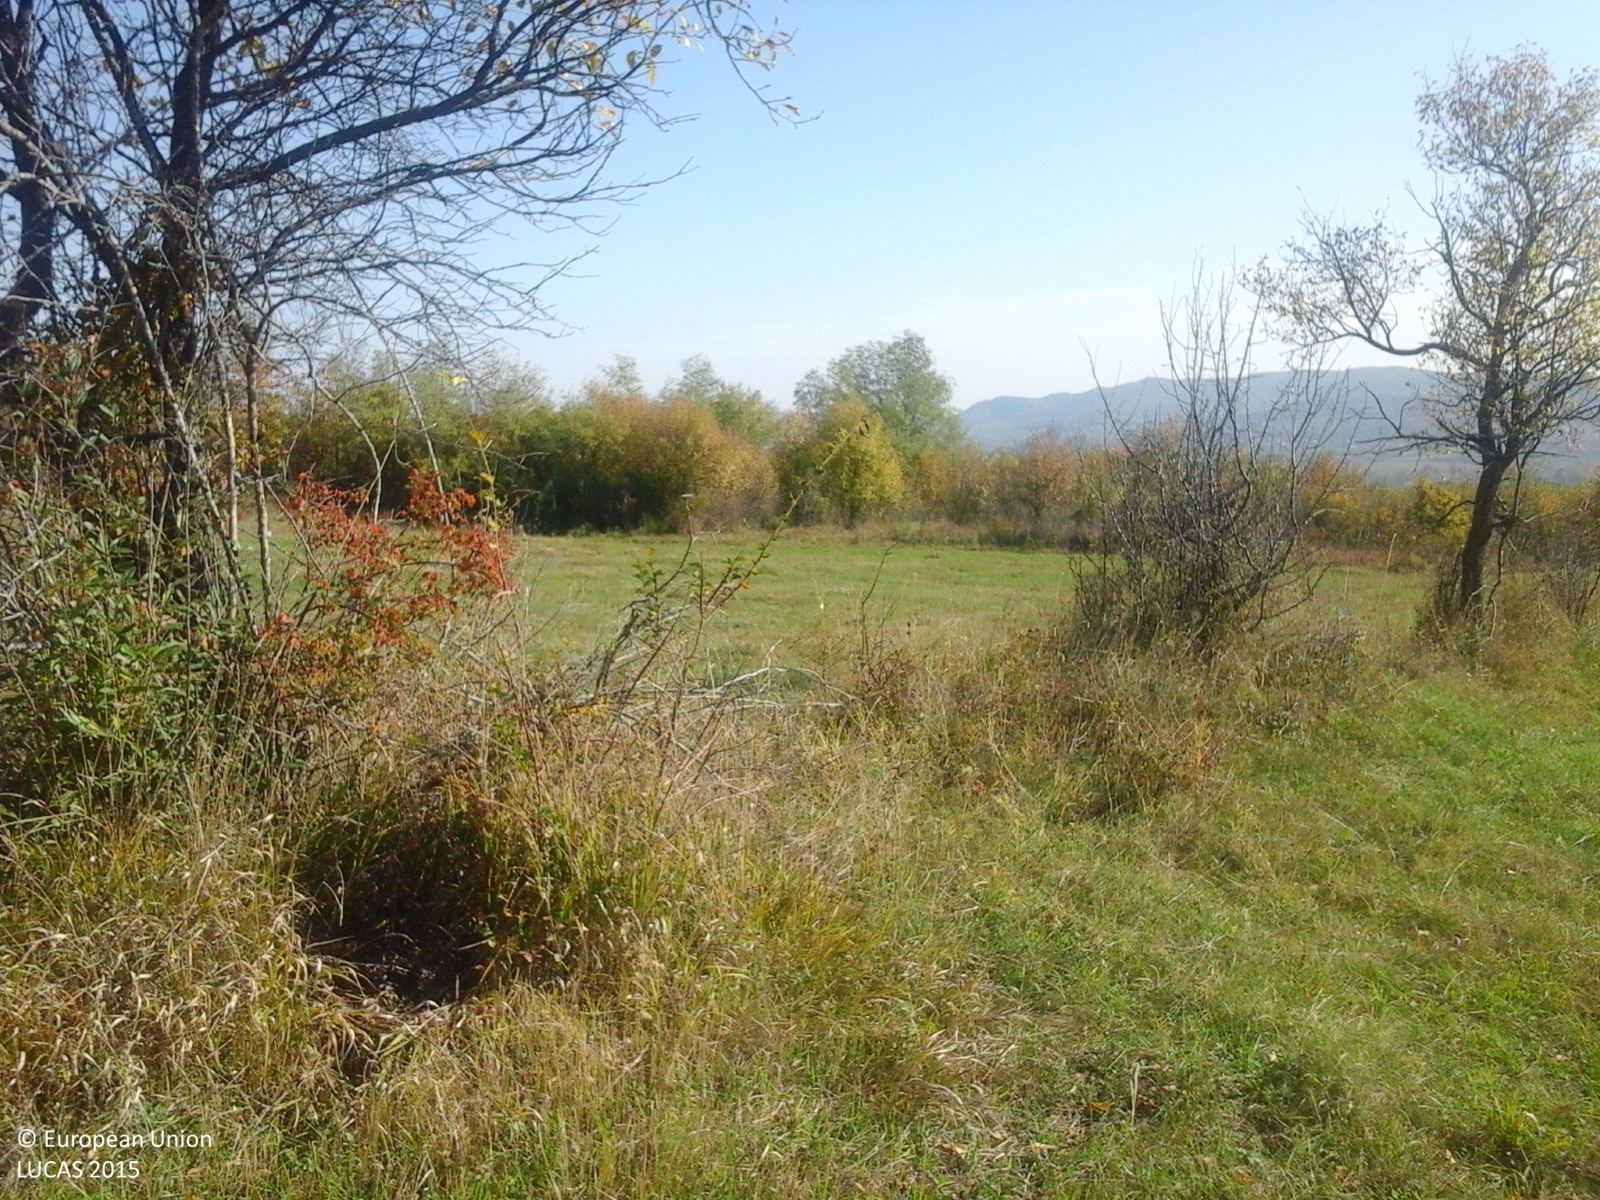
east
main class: Cropland
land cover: Other fruit trees and berries
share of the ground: > 75 %
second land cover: Grassland without tree/shrub cover
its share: > 75 %
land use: Agriculture (excluding fallow land and kitchen gardens)
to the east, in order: Other fruit trees and berries; Grassland without tree/shrub cover; Abandoned hedges; Grass margins; Tracks; Other fruit trees and berries
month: October
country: RO
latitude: 45.3053
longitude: 26.5650
